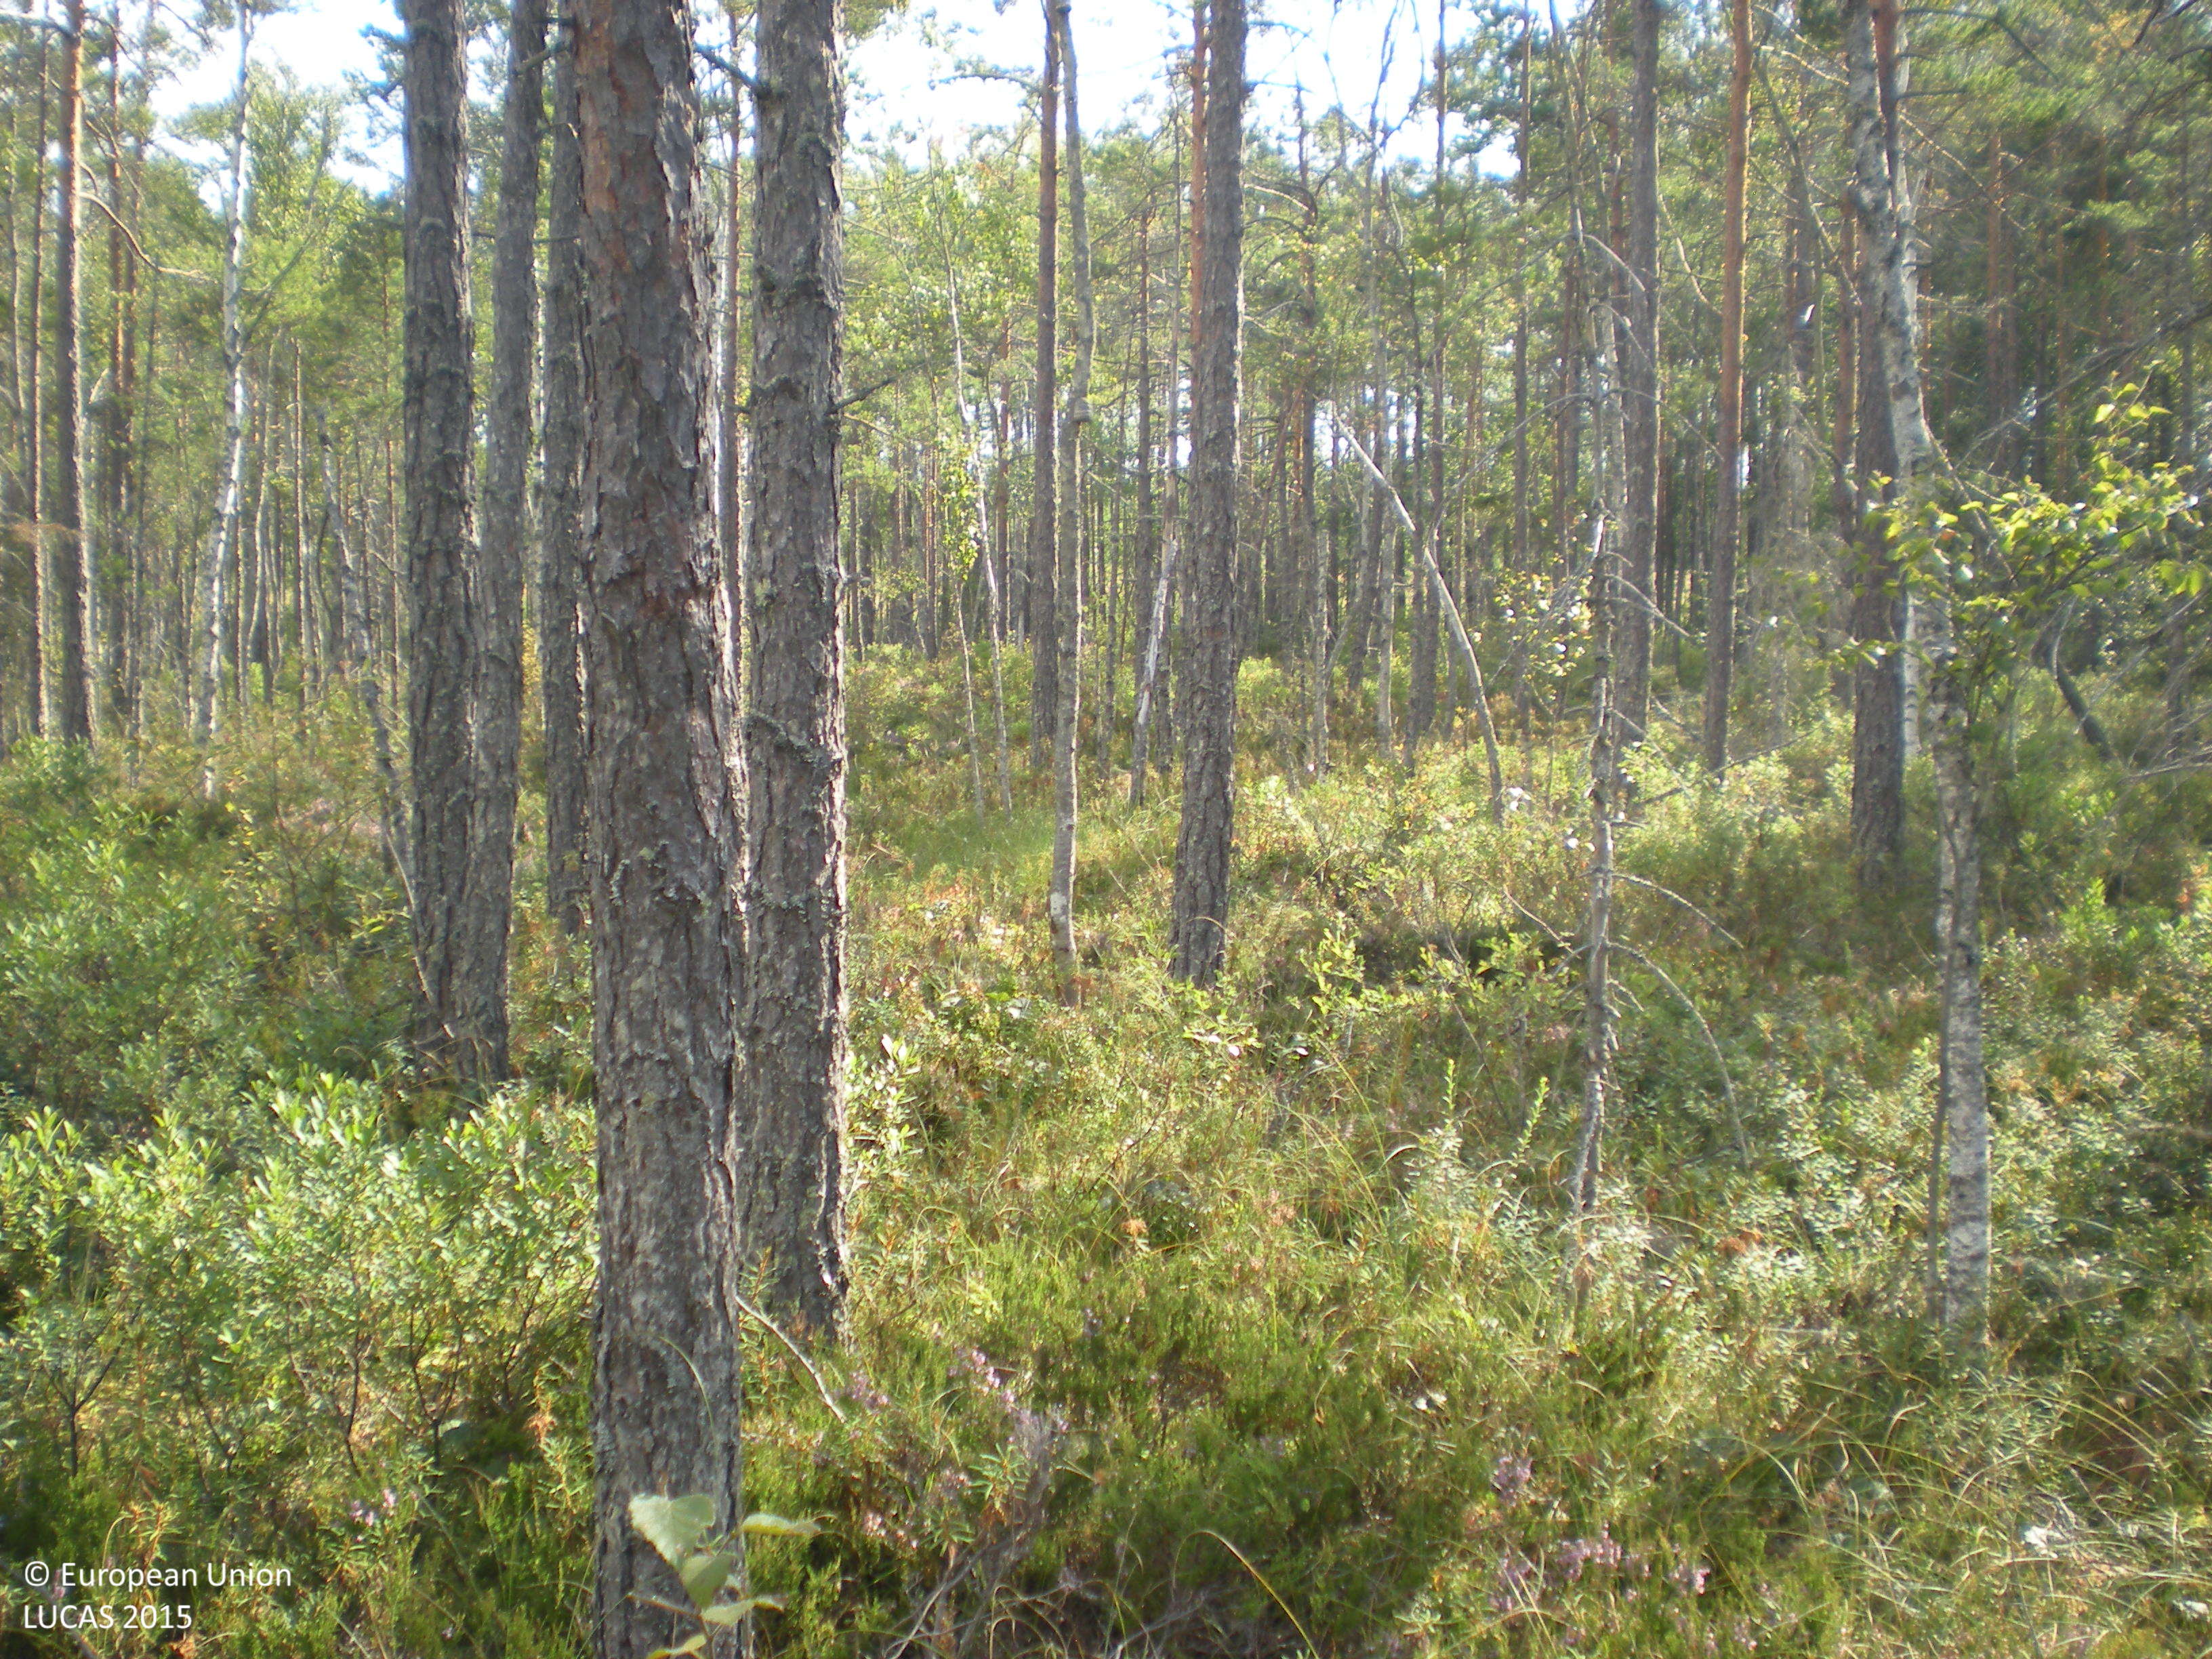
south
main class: Woodland
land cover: Pine dominated mixed woodland
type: boreal forest
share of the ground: 50 - 75 %
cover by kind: coniferous forest trees 45 %, shrubs 30 %, broadleaved forest trees 15 %, herbaceous plants 5 %, lichens and mosses 5 %
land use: Forestry
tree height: < 5 m
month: August
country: SE
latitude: 60.4003
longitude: 17.0867
